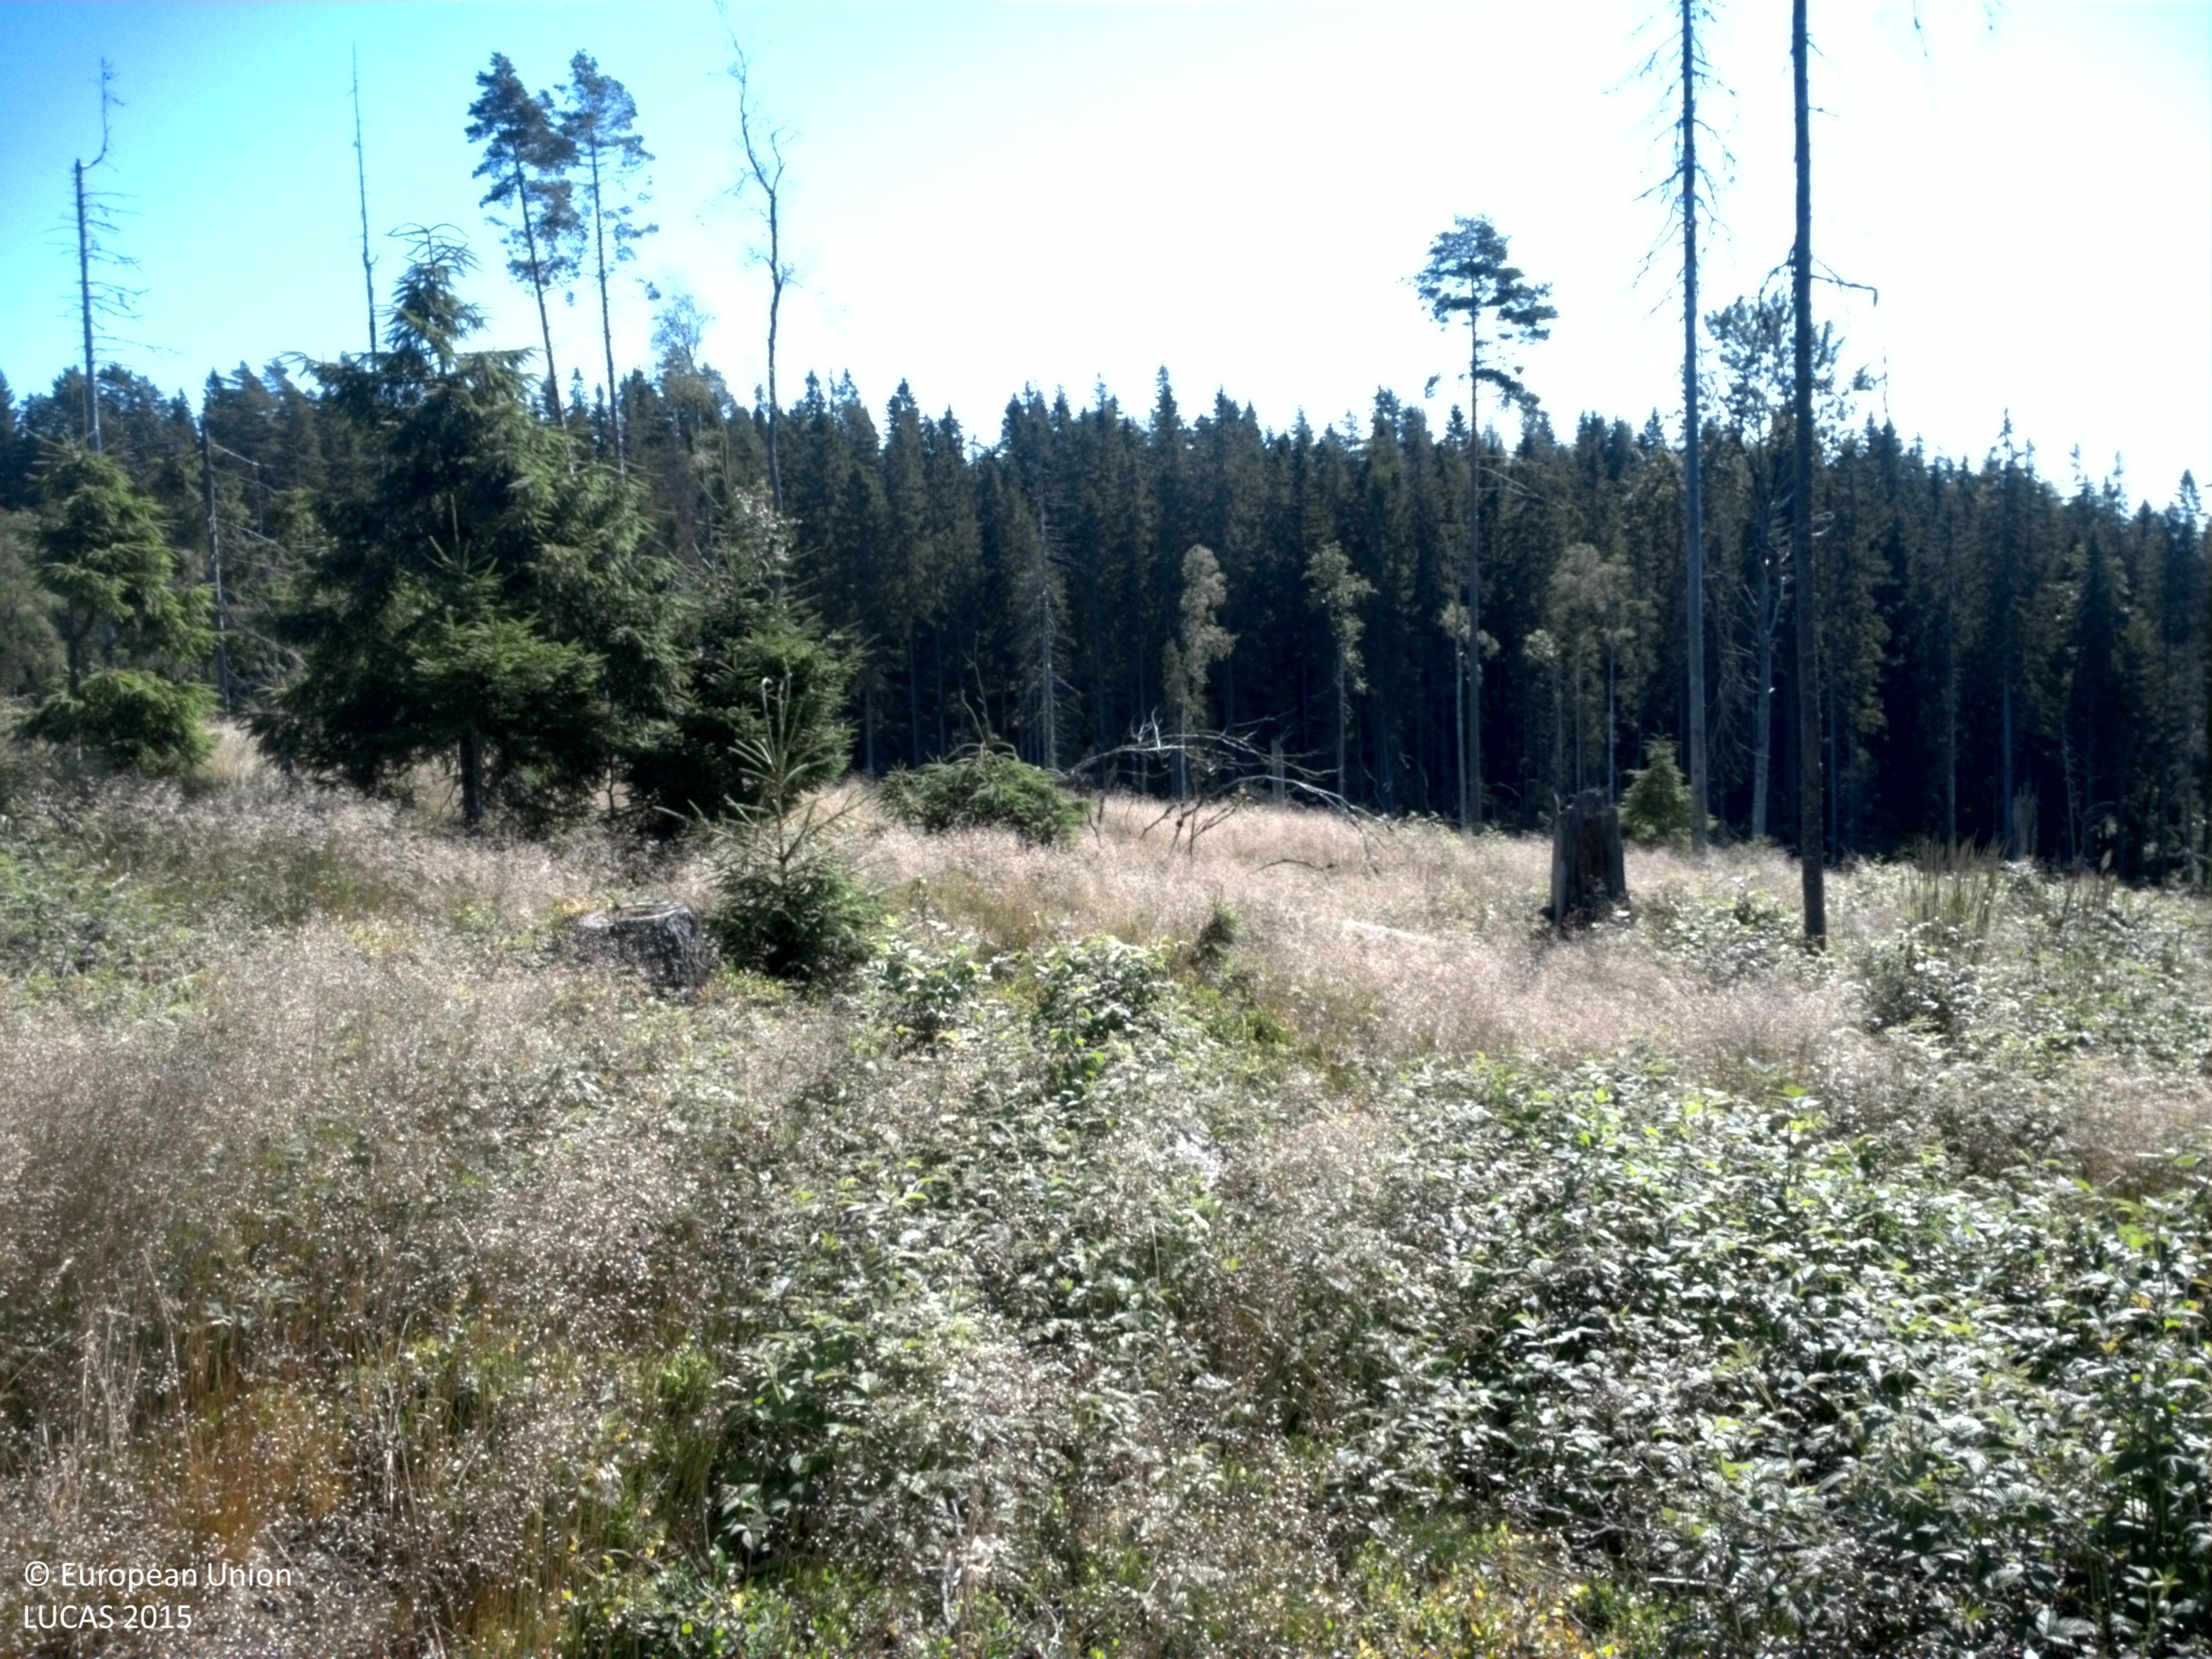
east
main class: Woodland
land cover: Spruce dominated coniferous woodland
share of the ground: 10 - 25 %
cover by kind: shrubs 45 %, herbaceous plants 40 %, coniferous forest trees 15 %
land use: Forestry
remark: Clear cut
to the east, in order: Spruce dominated coniferous woodland; Spruce dominated mixed woodland; Spruce dominated coniferous woodland; Rivers and streams; Spruce dominated coniferous woodland
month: July
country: SE
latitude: 59.7149
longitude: 14.4170
